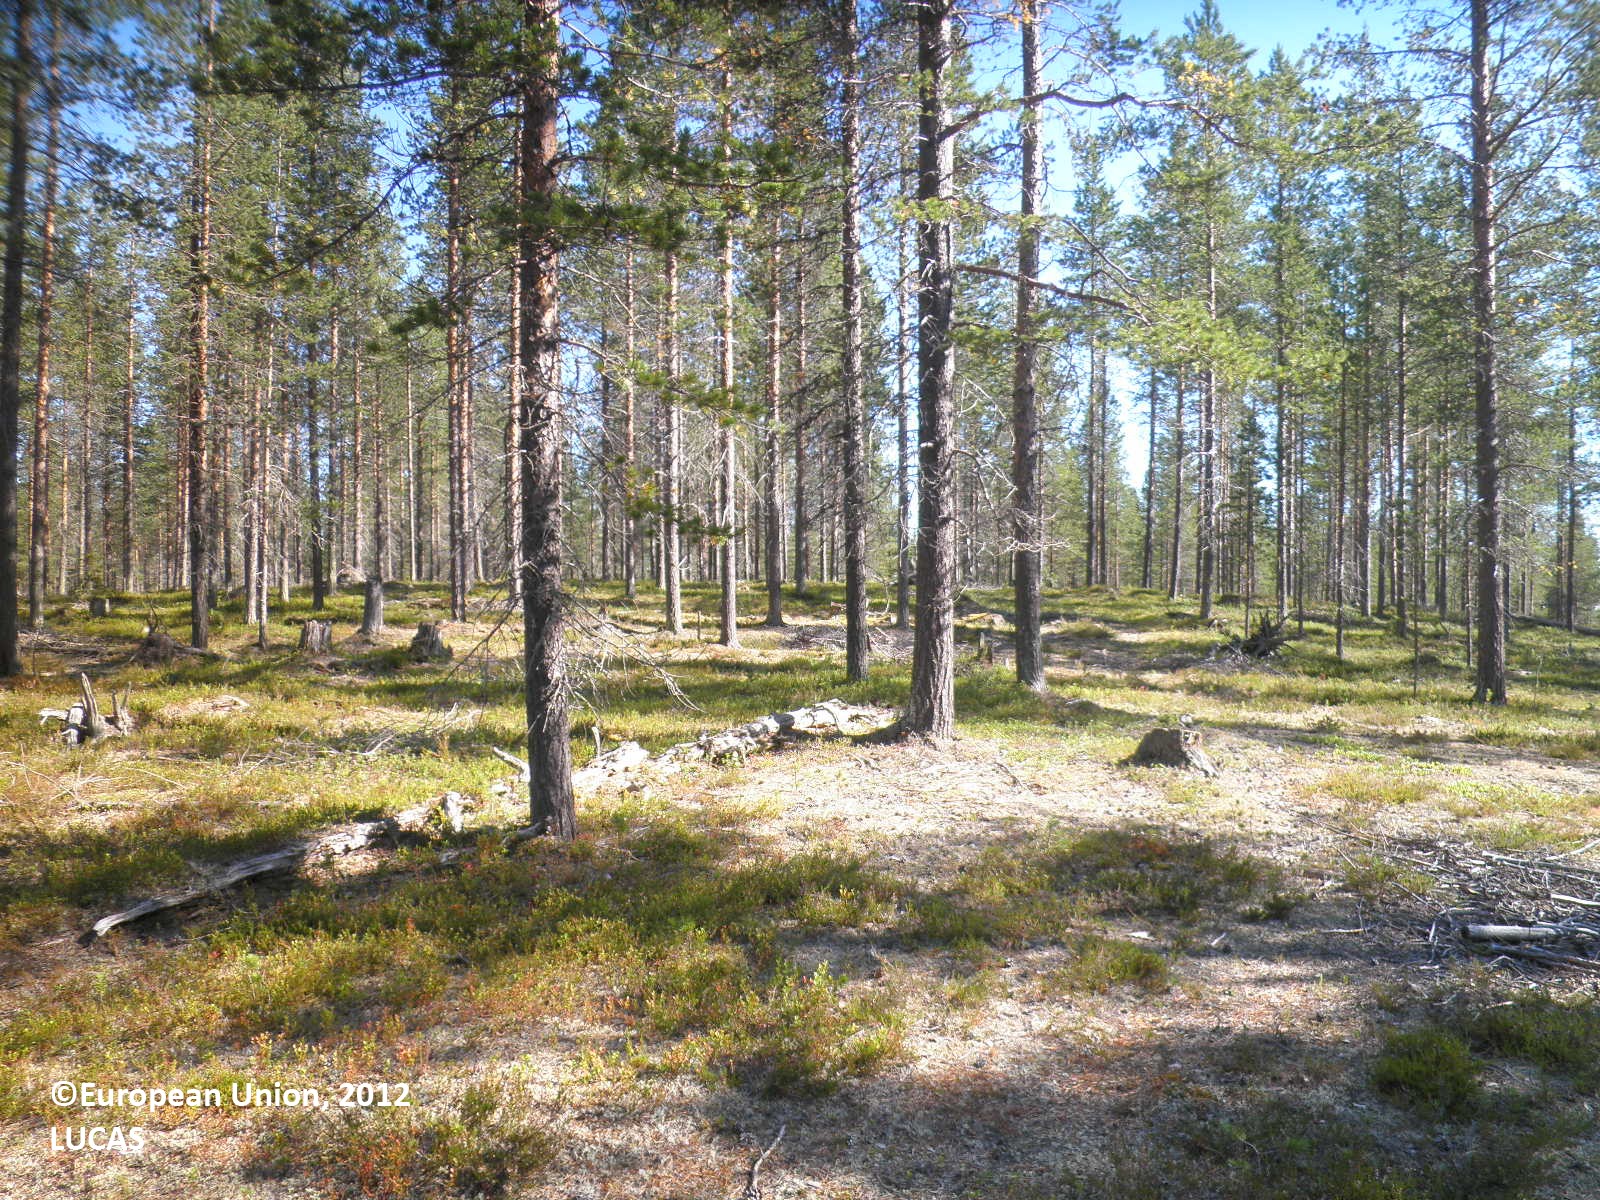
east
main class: Woodland
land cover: Pine dominated coniferous woodland
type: boreal forest
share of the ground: 25 - 50 %
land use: Forestry
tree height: > 5 m
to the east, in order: Pine dominated coniferous woodland
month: August
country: FI
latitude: 67.7313
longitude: 25.6315
